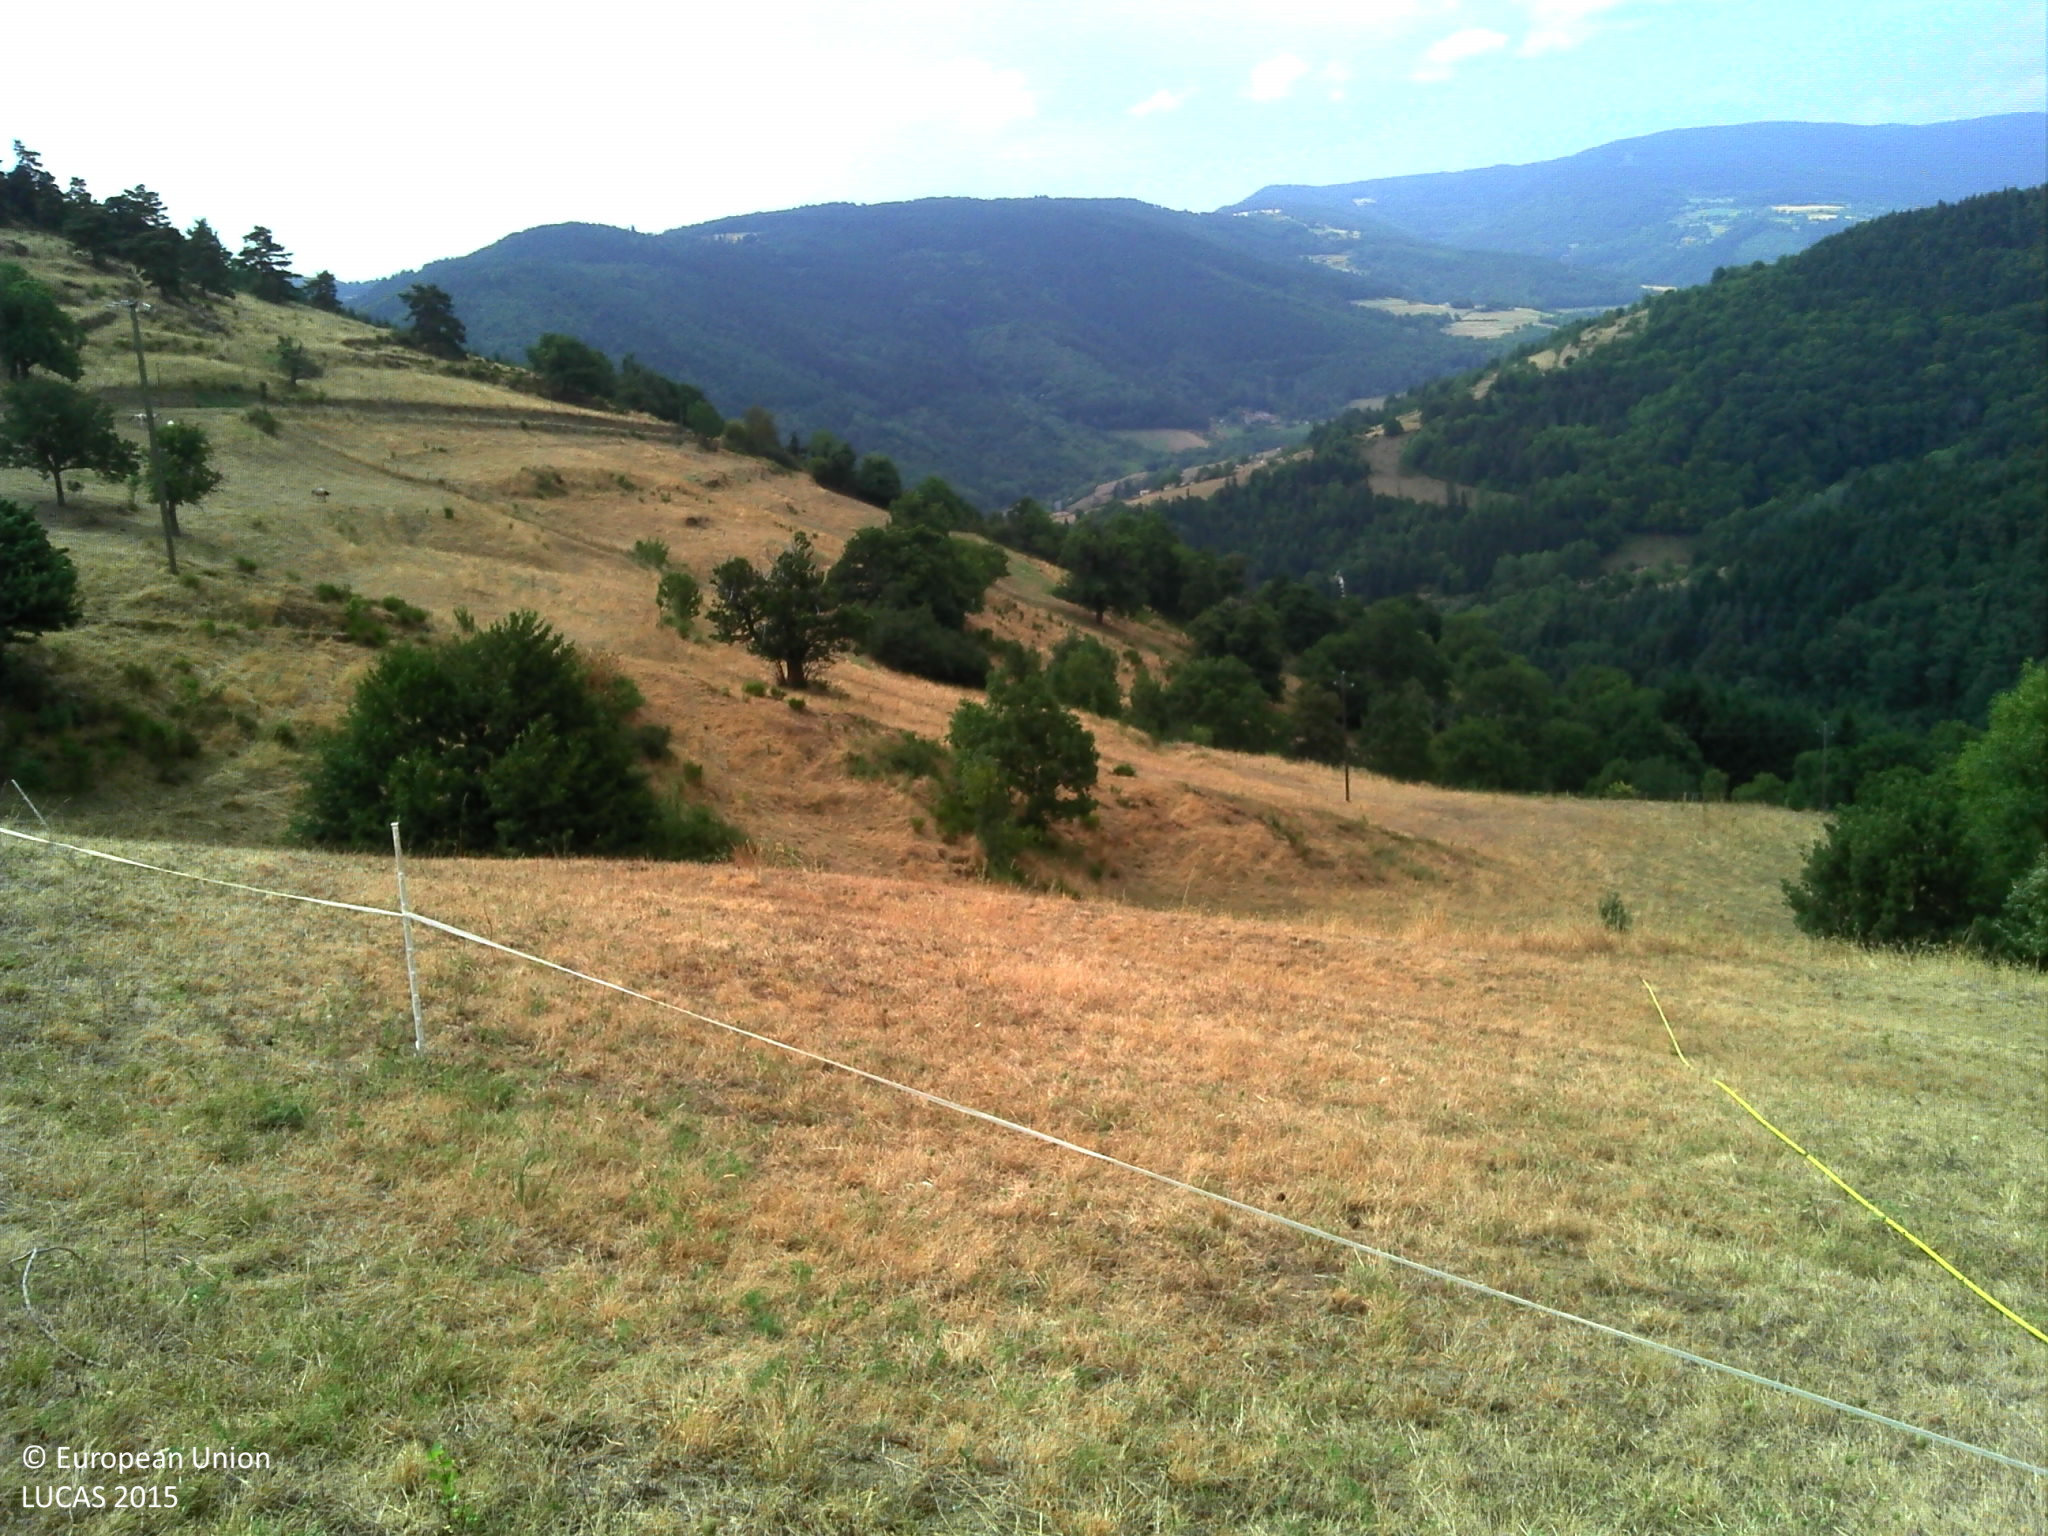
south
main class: Grassland
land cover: Grassland with sparse tree/shrub cover
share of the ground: > 75 %
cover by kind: herbaceous plants 95 %, broadleaved forest trees 5 %
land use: Agriculture (excluding fallow land and kitchen gardens)
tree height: > 5 m
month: August
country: FR
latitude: 45.3099
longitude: 4.5581
